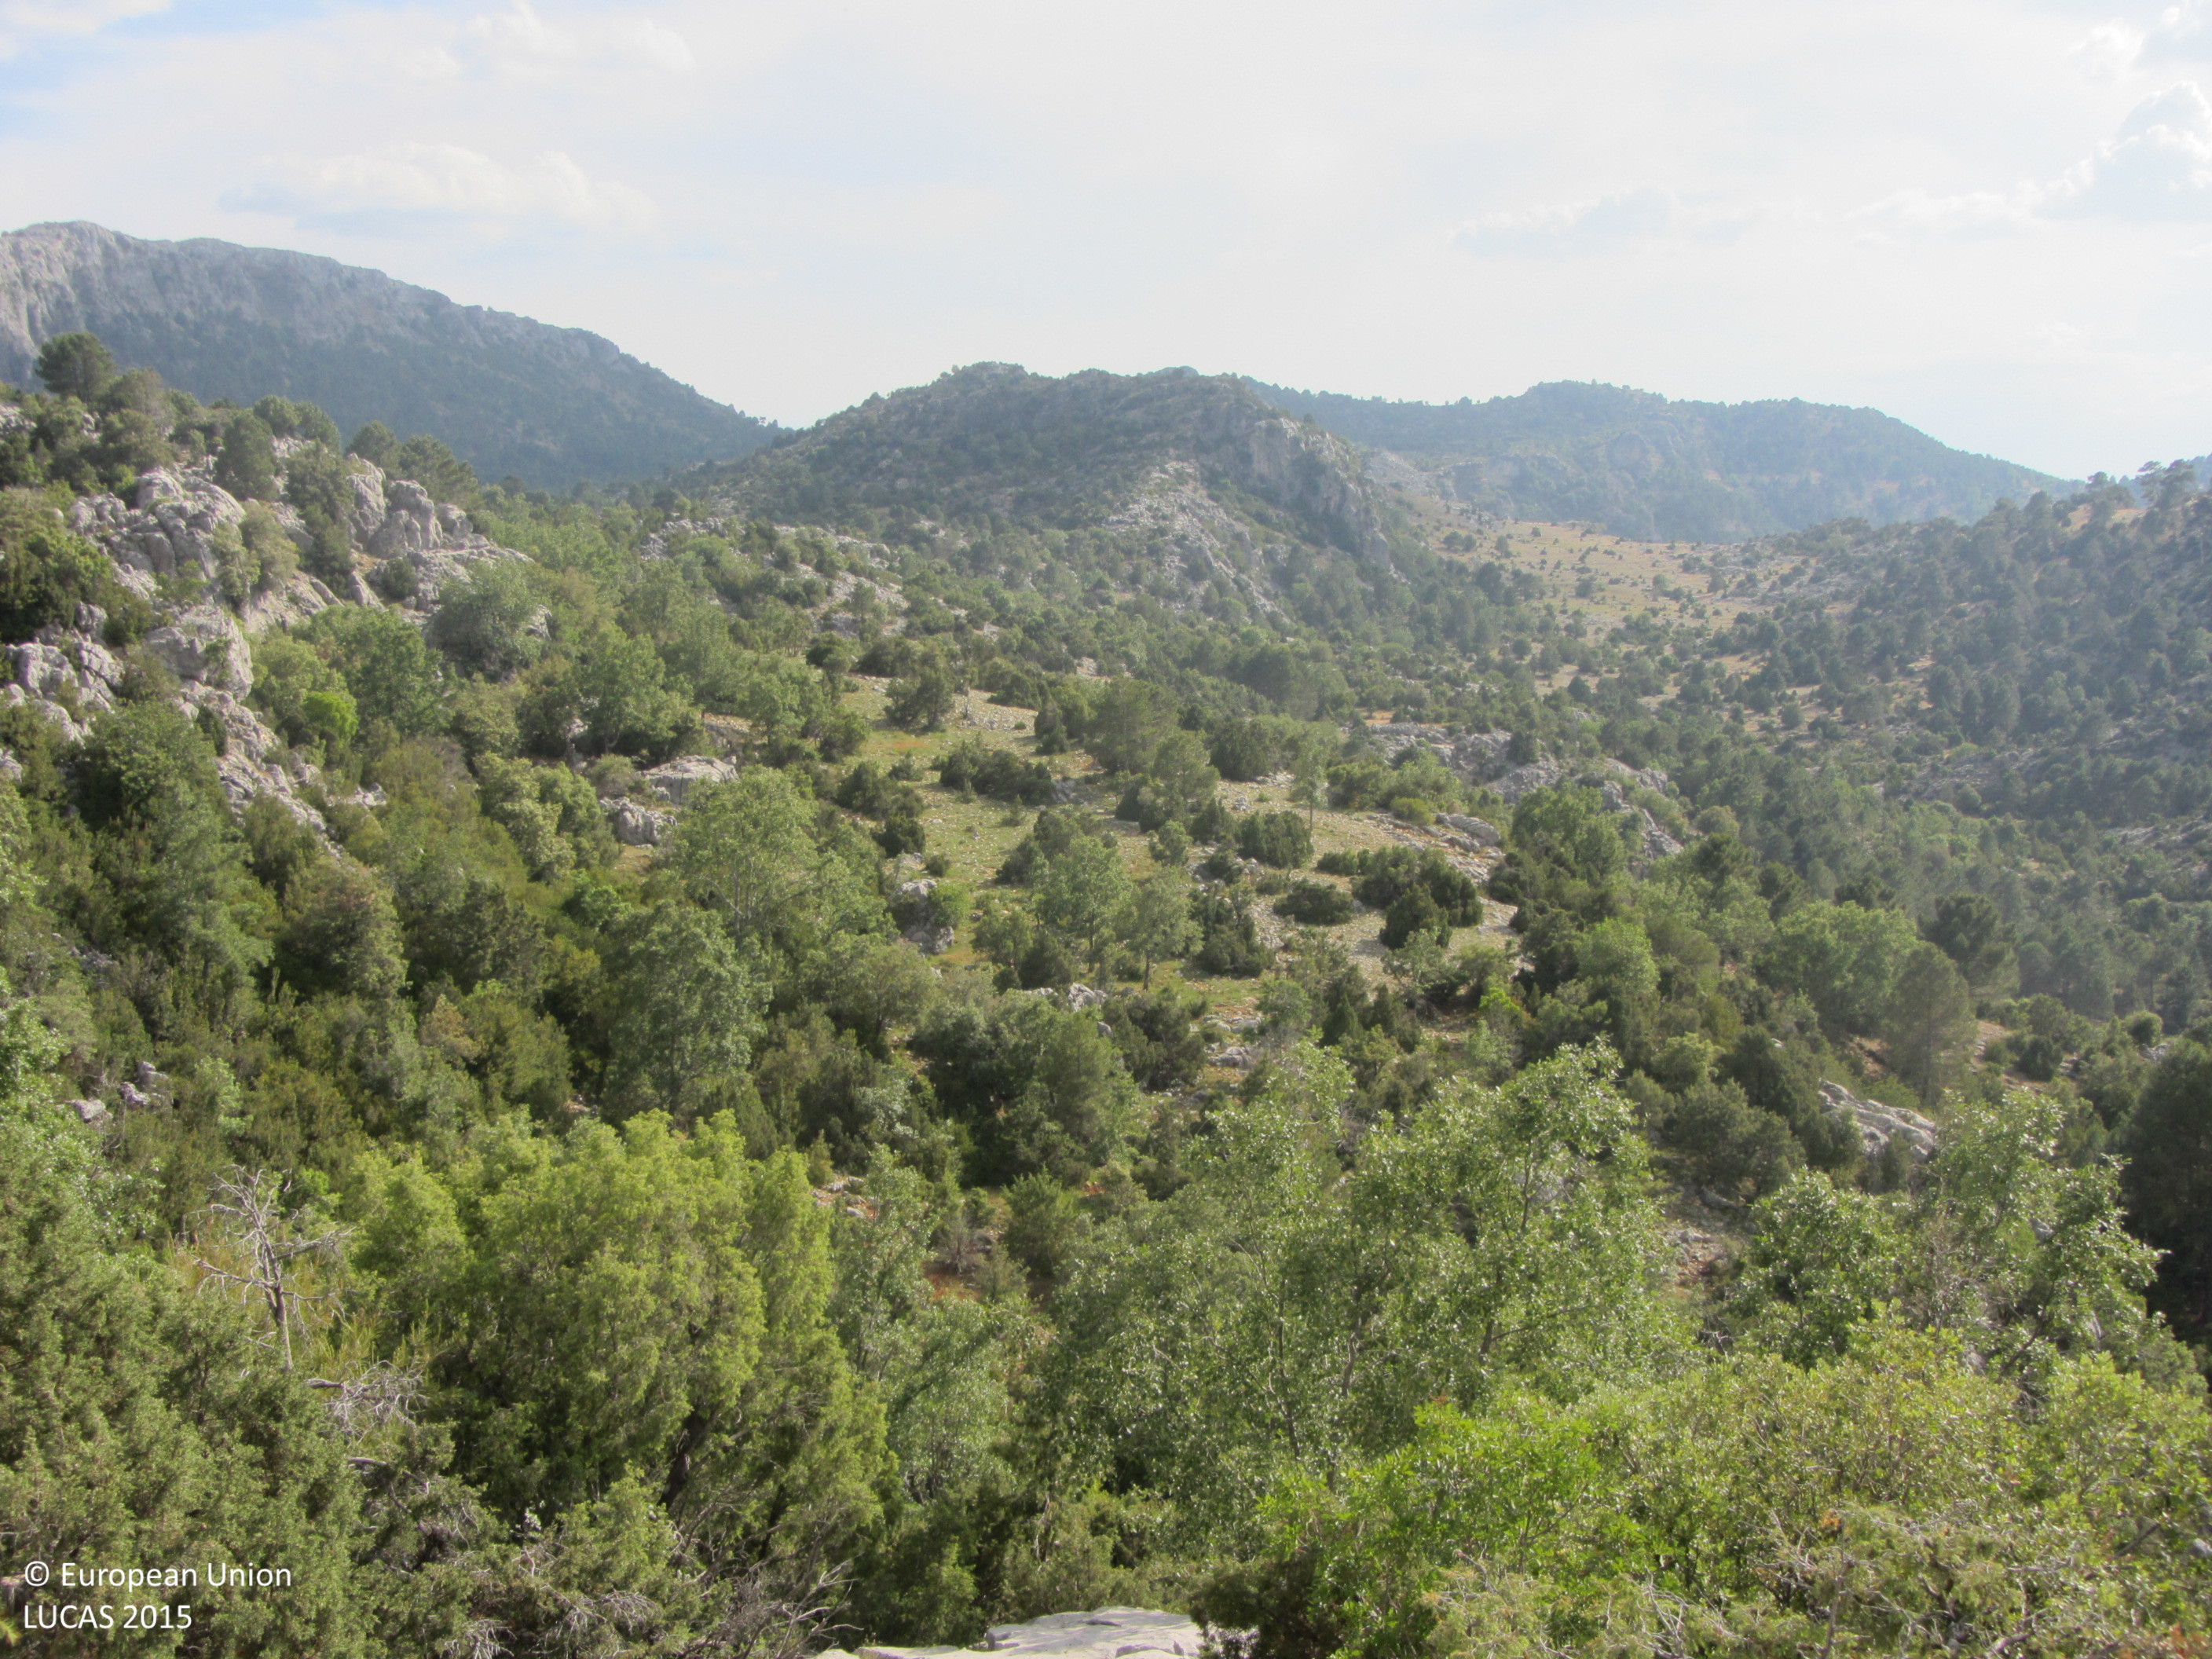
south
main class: Woodland
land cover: Pine dominated mixed woodland
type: broadleaved evergreen forest
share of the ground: 50 - 75 %
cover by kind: coniferous forest trees 40 %, broadleaved forest trees 25 %, consolidated bare surface 20 %, shrubs 15 %
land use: Semi-natural and natural areas not in use
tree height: > 5 m
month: May
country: ES
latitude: 38.0943
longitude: -2.8931
